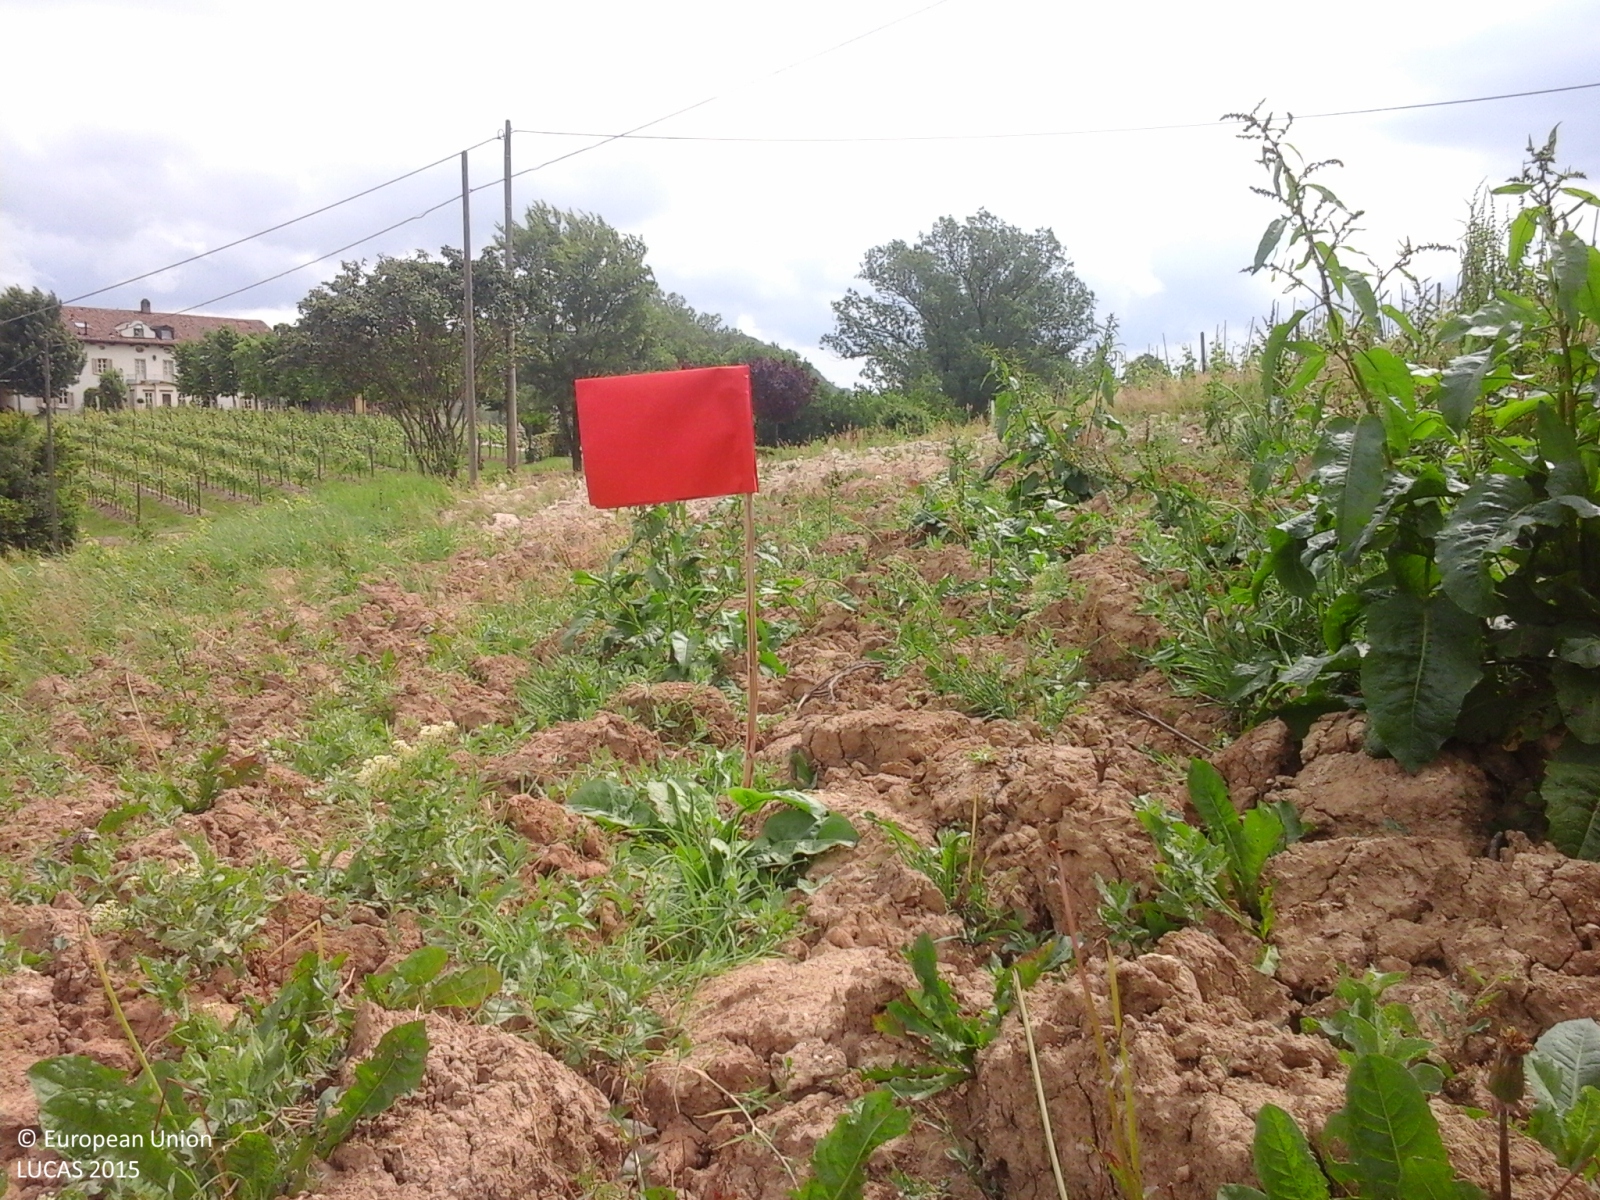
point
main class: Grassland
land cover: Spontaneously vegetated surfaces
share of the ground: > 75 %
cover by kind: unconsolidated bare surface 60 %, herbaceous plants 40 %
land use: Fallow land
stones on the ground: < 10 %
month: May
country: IT
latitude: 44.7695
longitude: 8.2976
